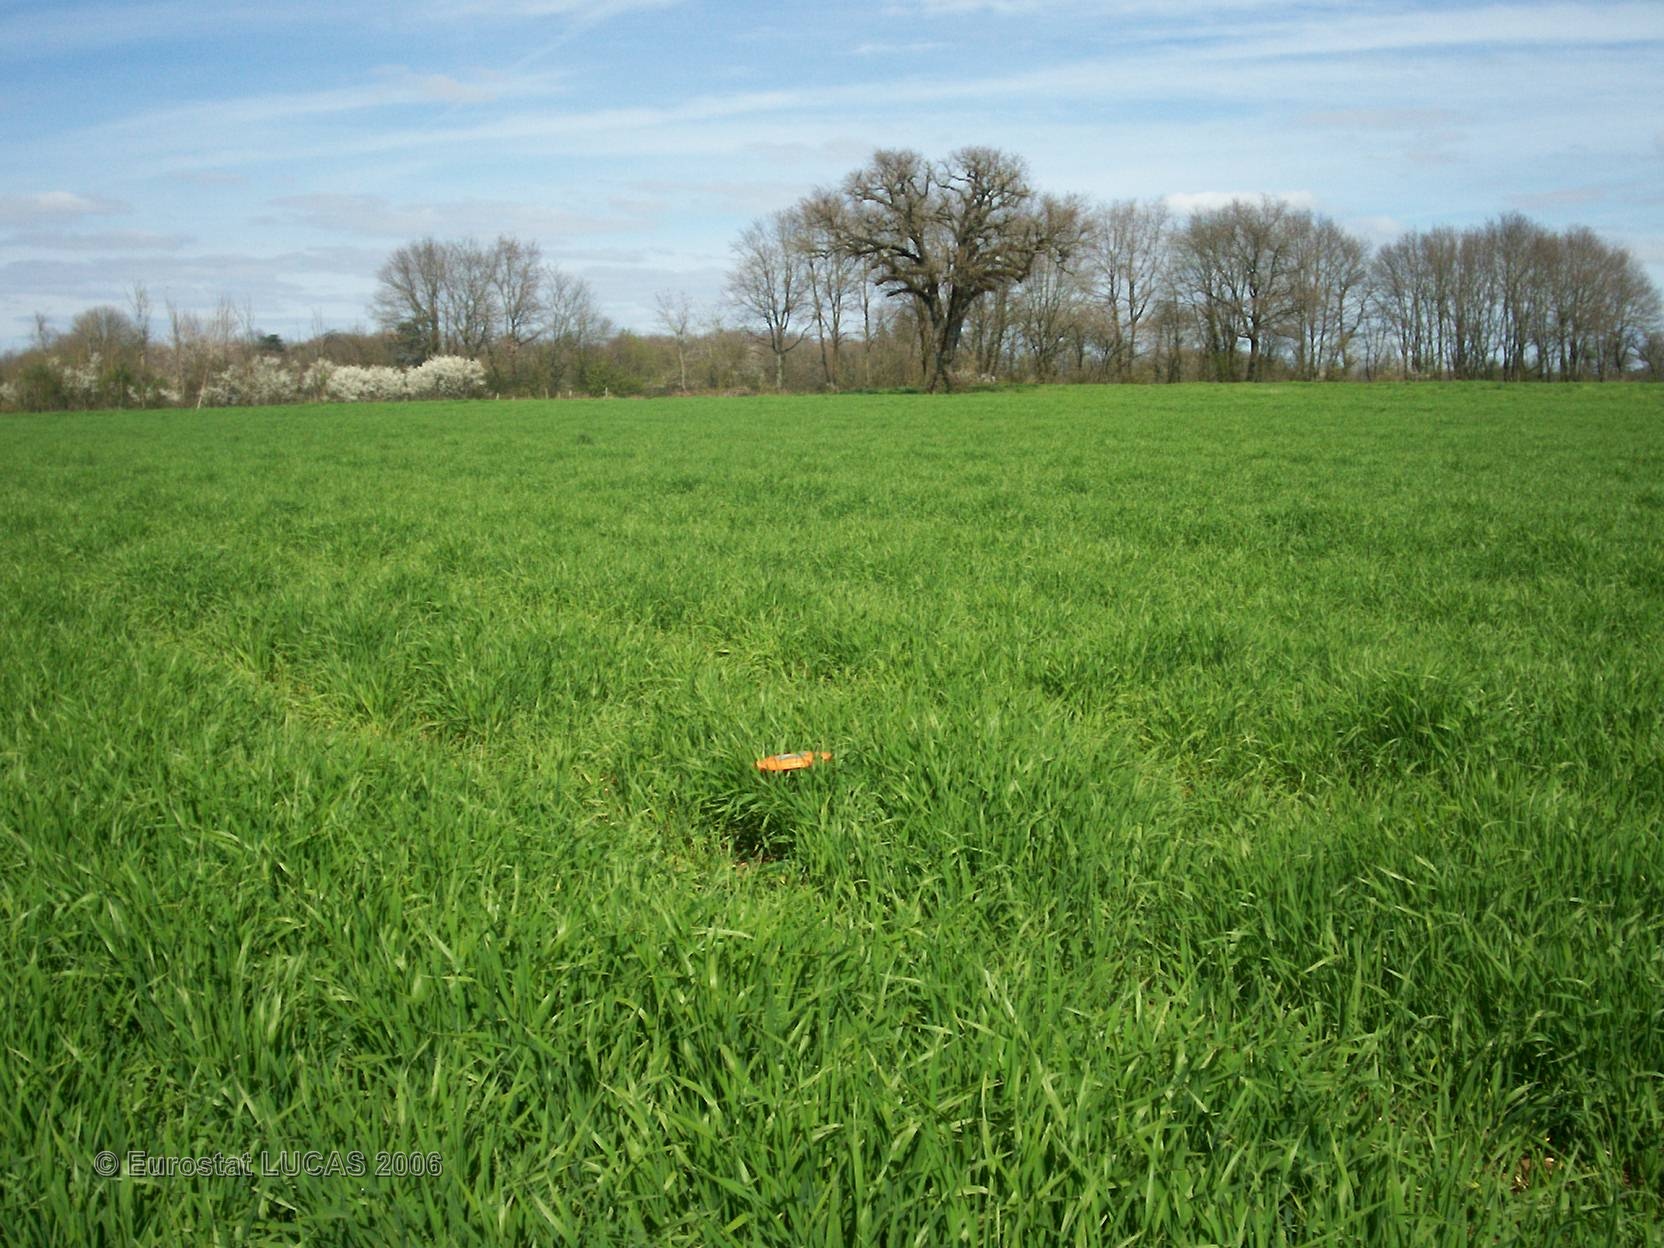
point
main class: Cropland
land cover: Barley
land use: Agriculture (excluding fallow land and kitchen gardens)
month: April
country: FR
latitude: 46.4347
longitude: 0.4951
